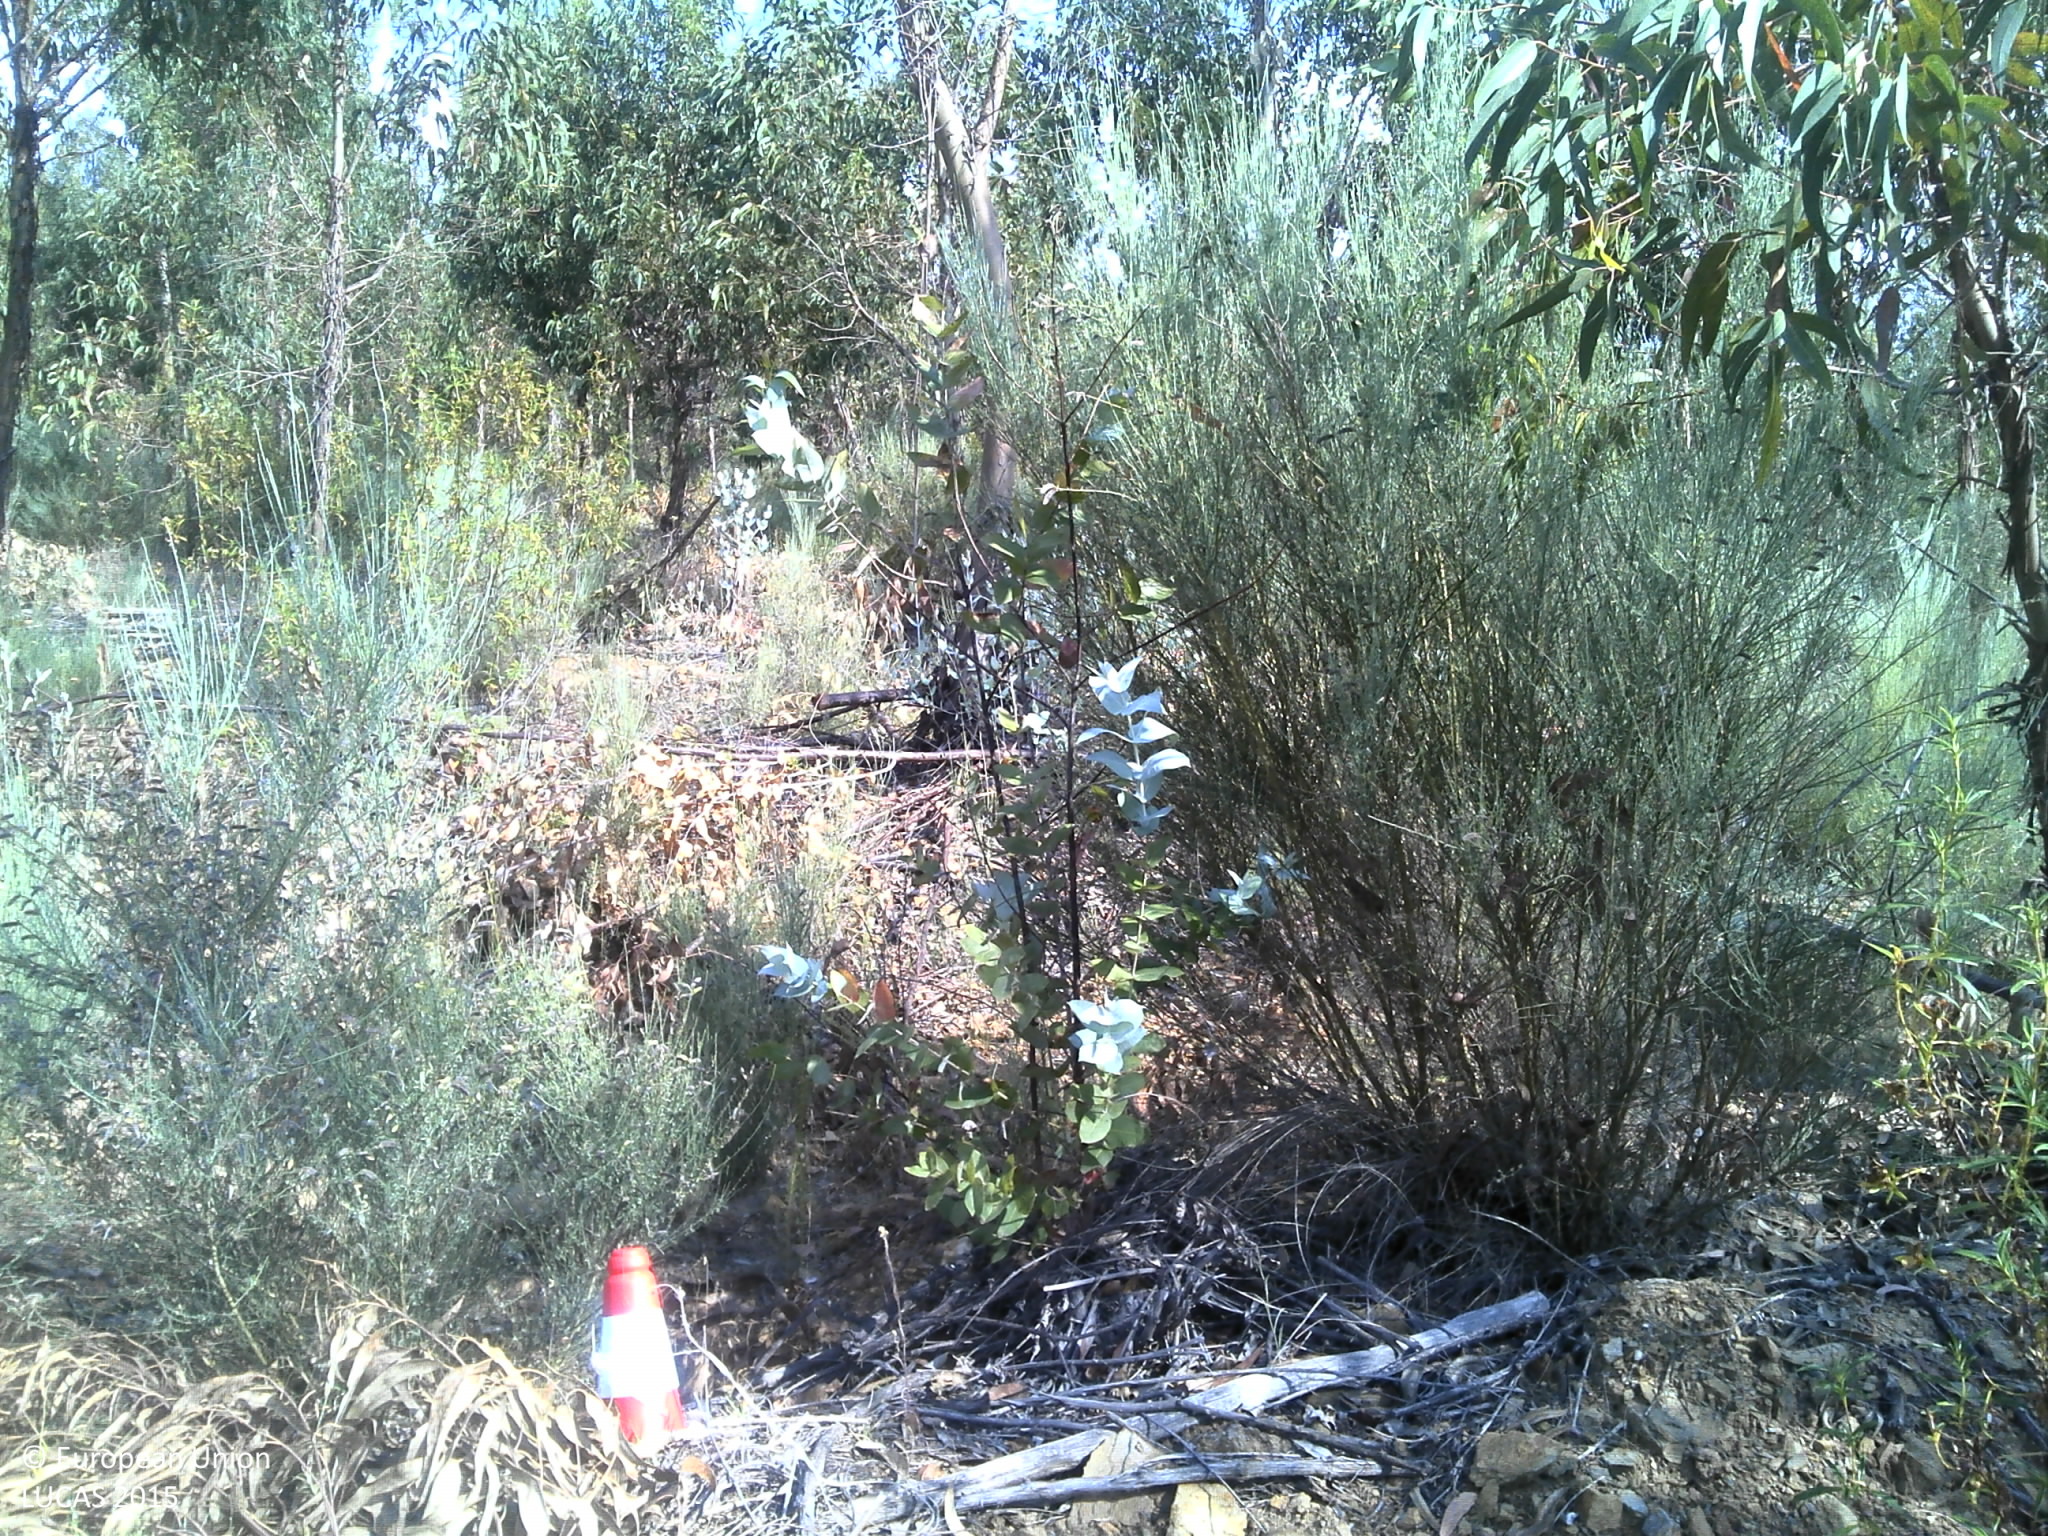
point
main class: Woodland
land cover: Broadleaved woodland
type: exotic forest
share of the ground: 25 - 50 %
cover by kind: broadleaved forest trees 50 %, unconsolidated bare surface 30 %, shrubs 20 %
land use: Forestry
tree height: > 5 m
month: June
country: PT
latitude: 40.2268
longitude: -7.3189
